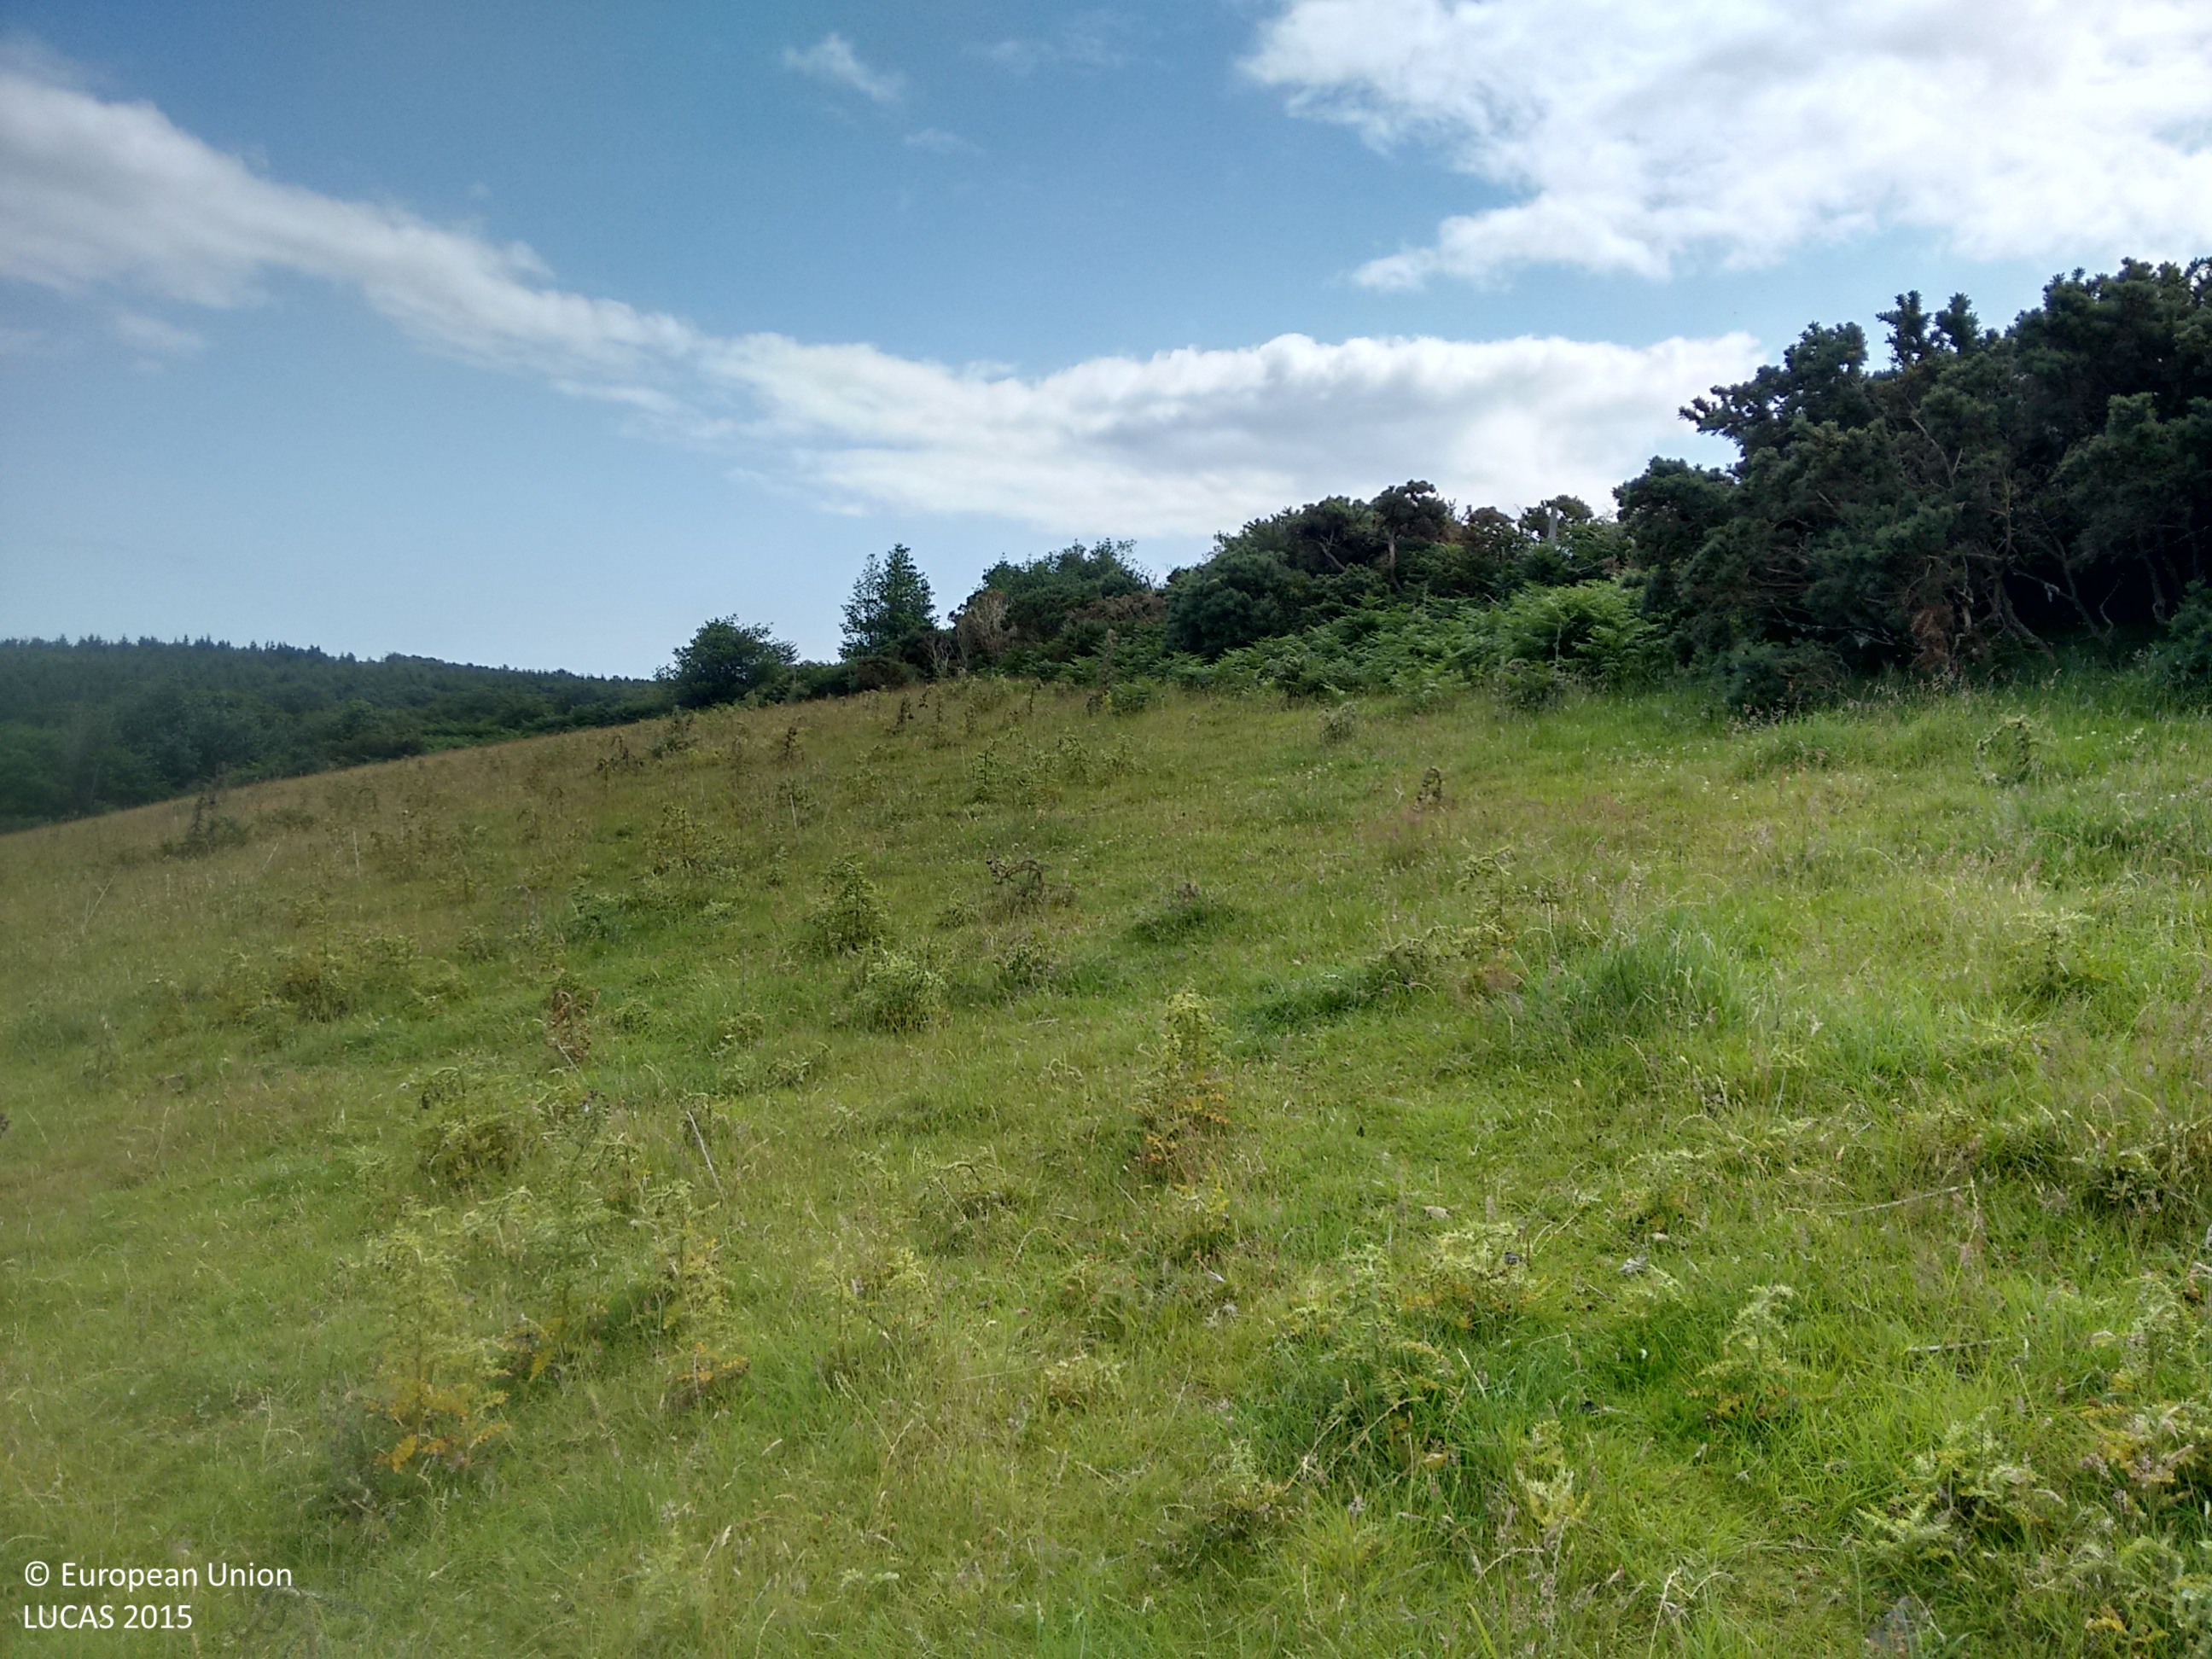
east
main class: Grassland
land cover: Grassland without tree/shrub cover
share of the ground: > 75 %
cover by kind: herbaceous plants 100 %
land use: Agriculture (excluding fallow land and kitchen gardens)
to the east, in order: Grassland without tree/shrub cover; Fences; Managed hedges; Grassland without tree/shrub cover; Fences; Managed hedges; Spontaneously vegetated surfaces; Broadleaved woodland
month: July
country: IE
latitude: 53.1369
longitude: -6.1256
